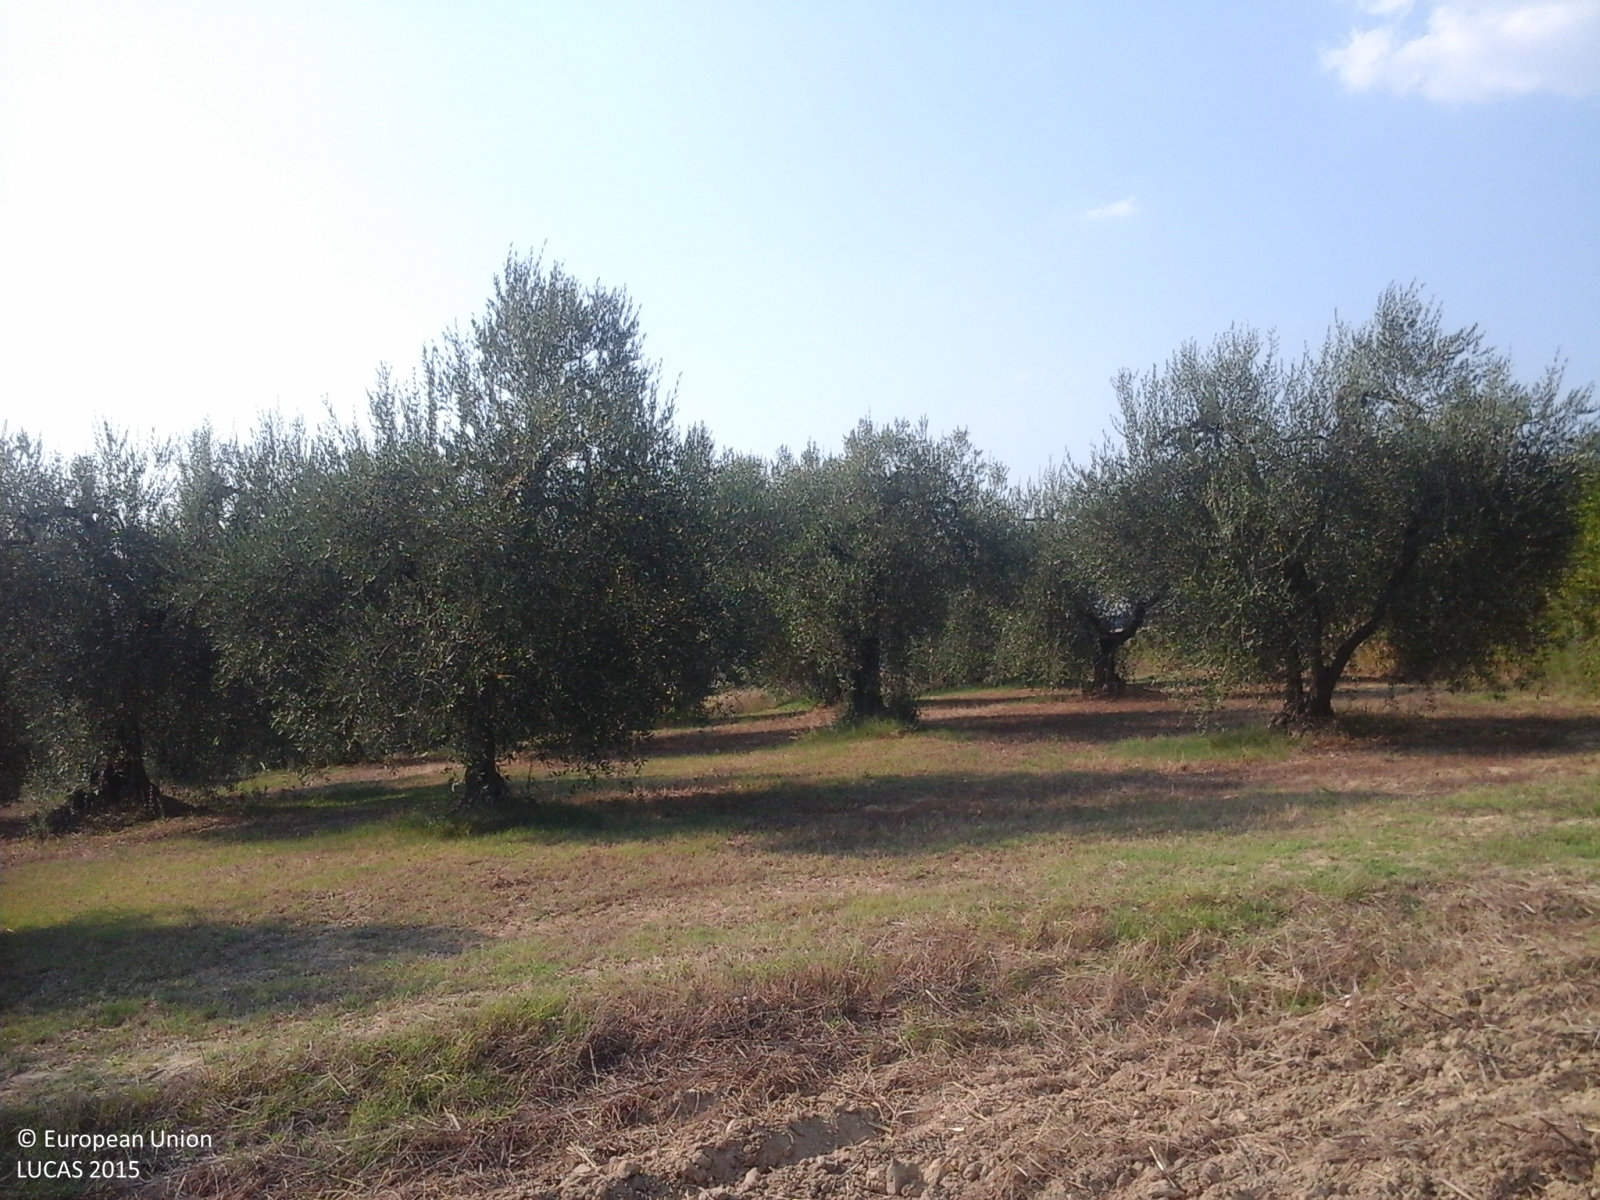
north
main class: Cropland
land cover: Sunflower
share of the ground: 10 - 25 %
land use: Agriculture (excluding fallow land and kitchen gardens)
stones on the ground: < 10 %
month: August
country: IT
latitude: 42.5377
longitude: 12.2937
